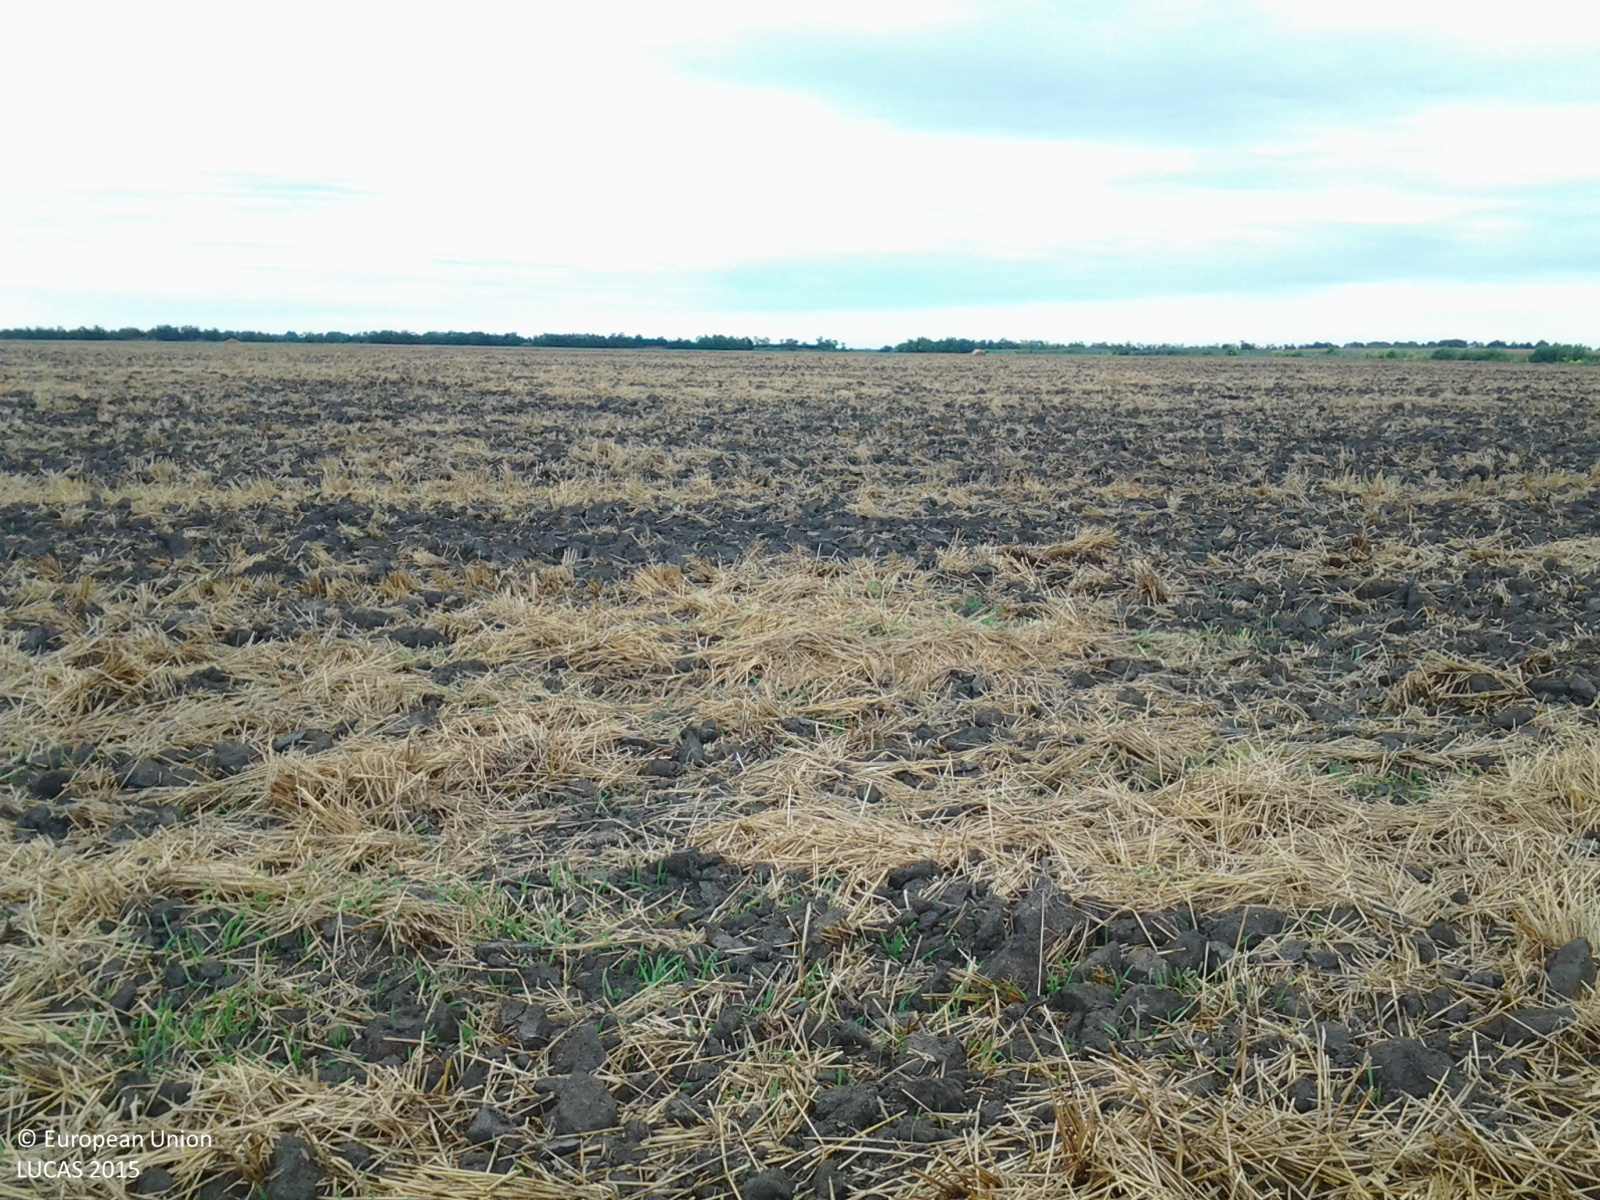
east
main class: Cropland
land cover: Barley
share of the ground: < 10 %
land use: Agriculture (excluding fallow land and kitchen gardens)
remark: Harvested field
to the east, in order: Barley
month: July
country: HU
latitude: 47.1719
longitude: 20.5452
